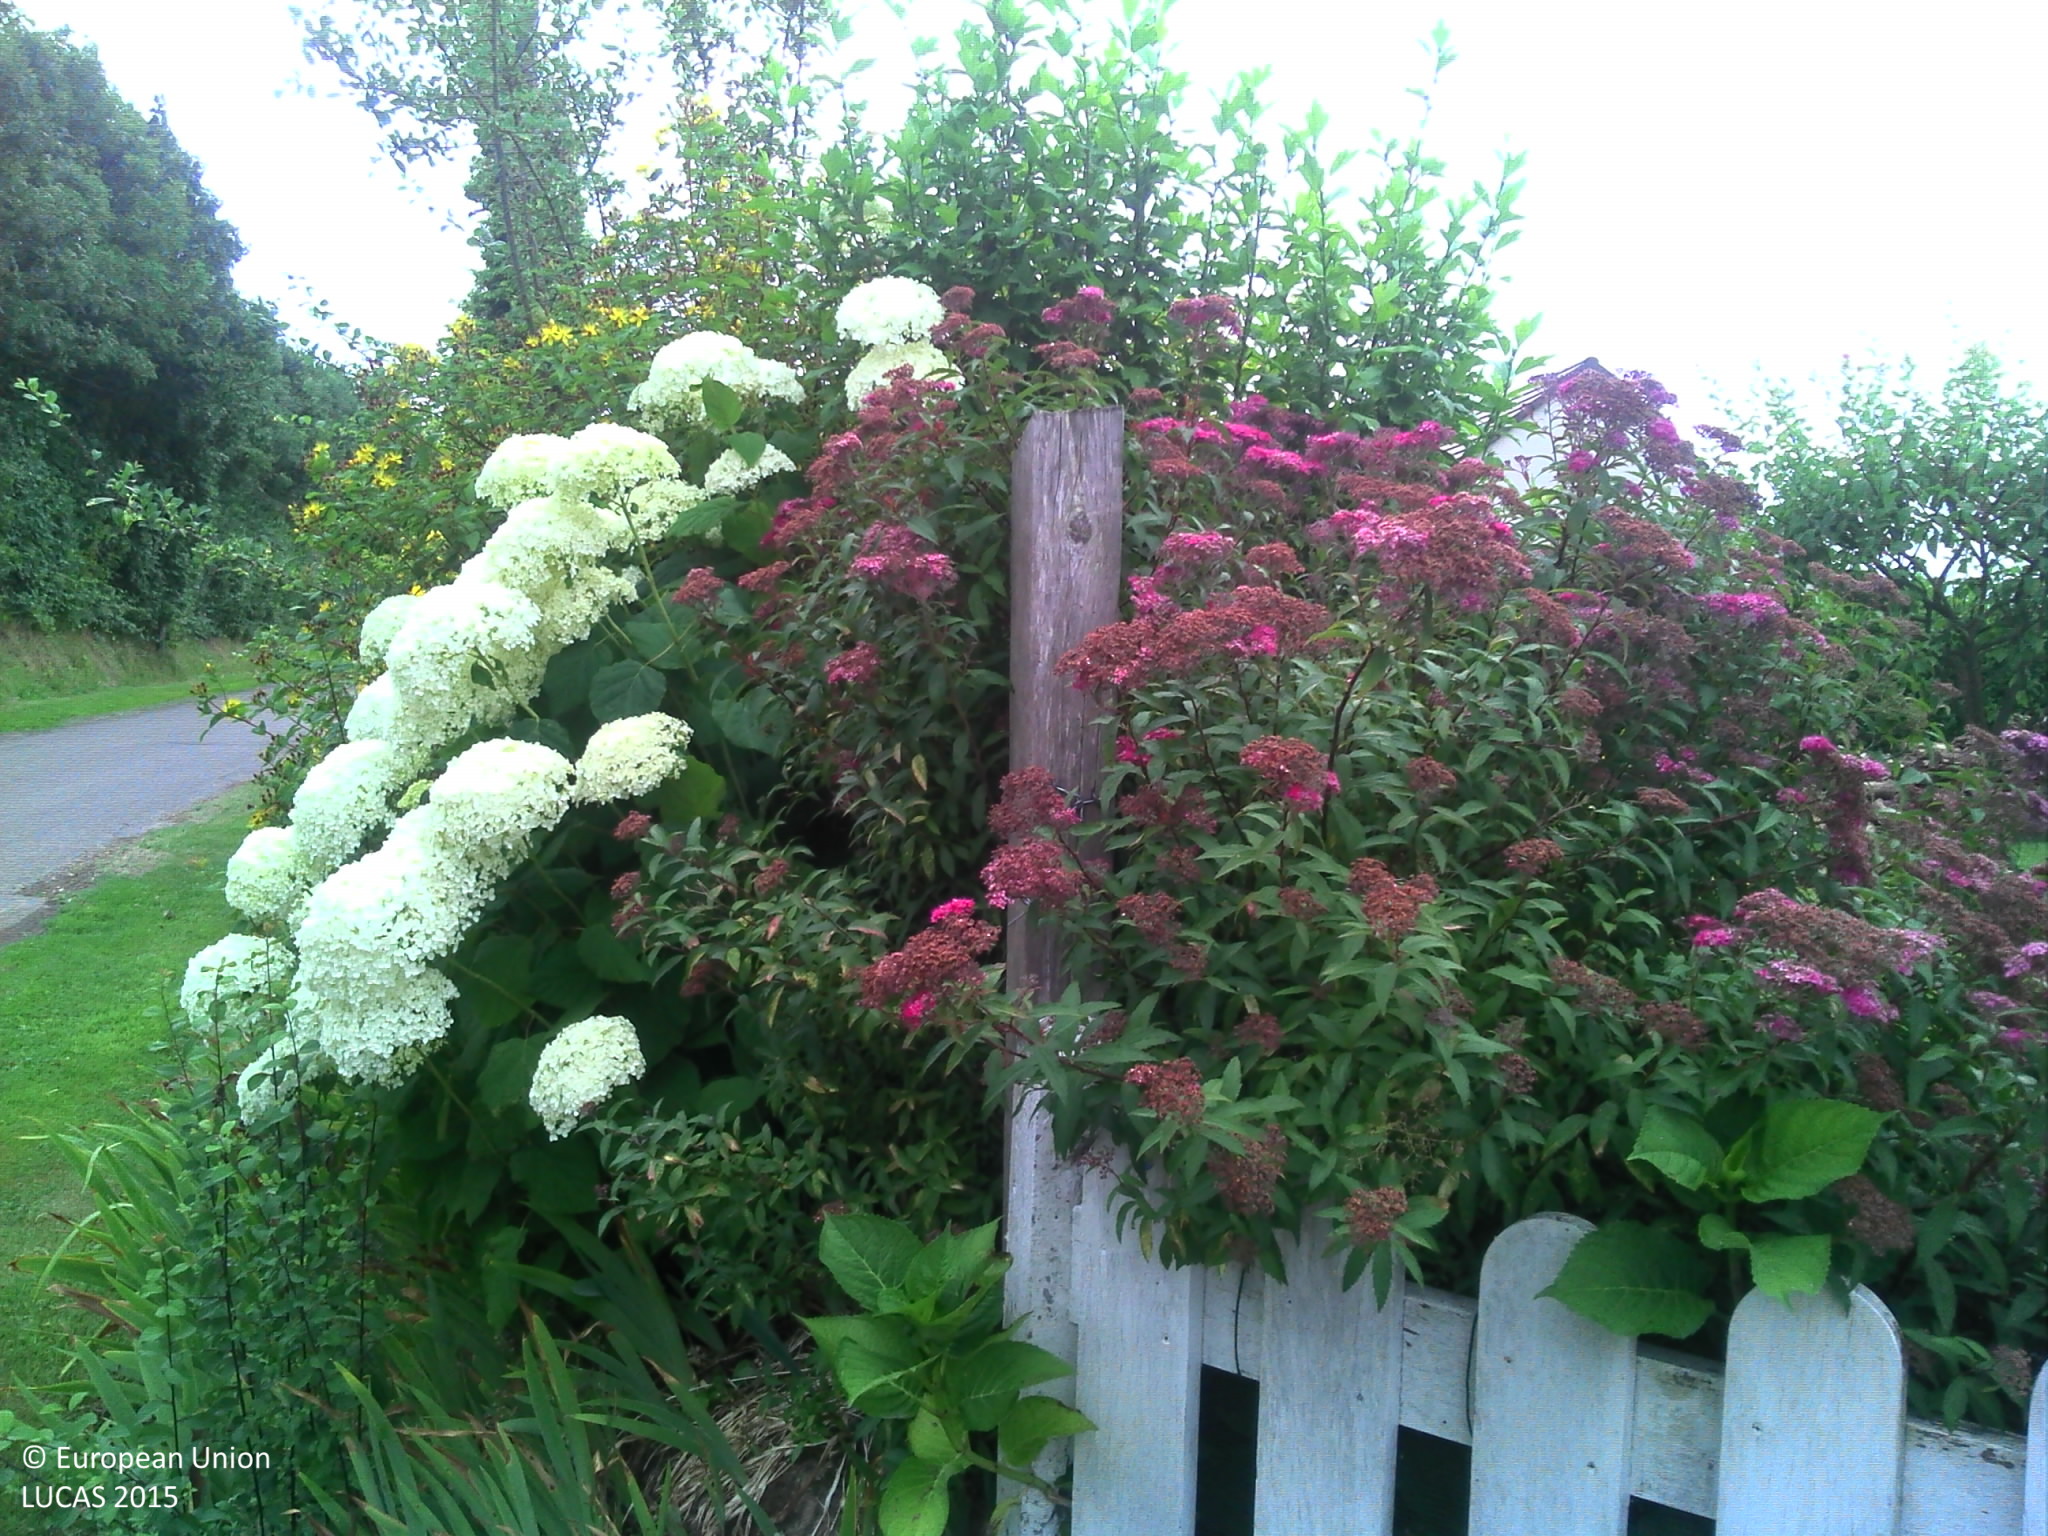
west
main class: Grassland
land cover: Grassland with sparse tree/shrub cover
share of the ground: > 75 %
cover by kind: herbaceous plants 95 %, broadleaved forest trees 5 %
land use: Residential
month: July
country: FR
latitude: 49.2528
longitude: 0.3969
